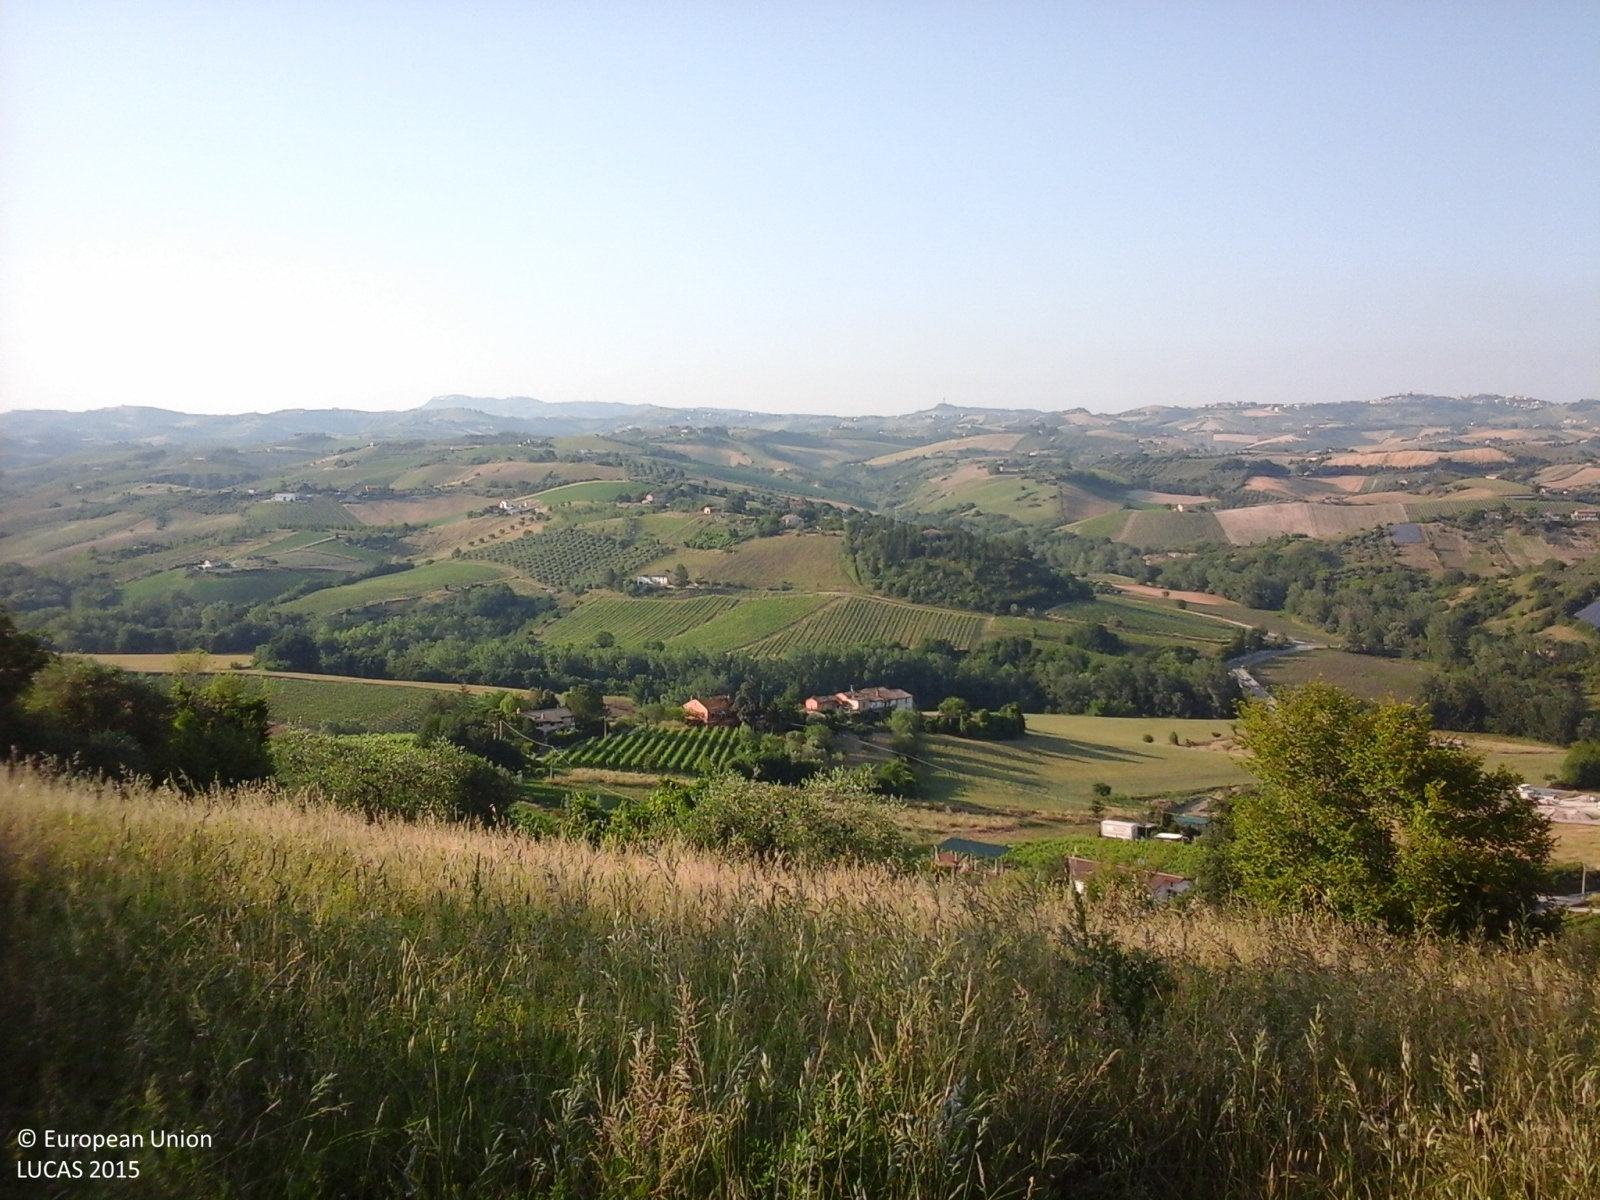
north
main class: Shrubland
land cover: Shrubland without tree cover
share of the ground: > 75 %
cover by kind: shrubs 100 %
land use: Semi-natural and natural areas not in use
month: June
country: IT
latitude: 42.8910
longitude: 13.7733
